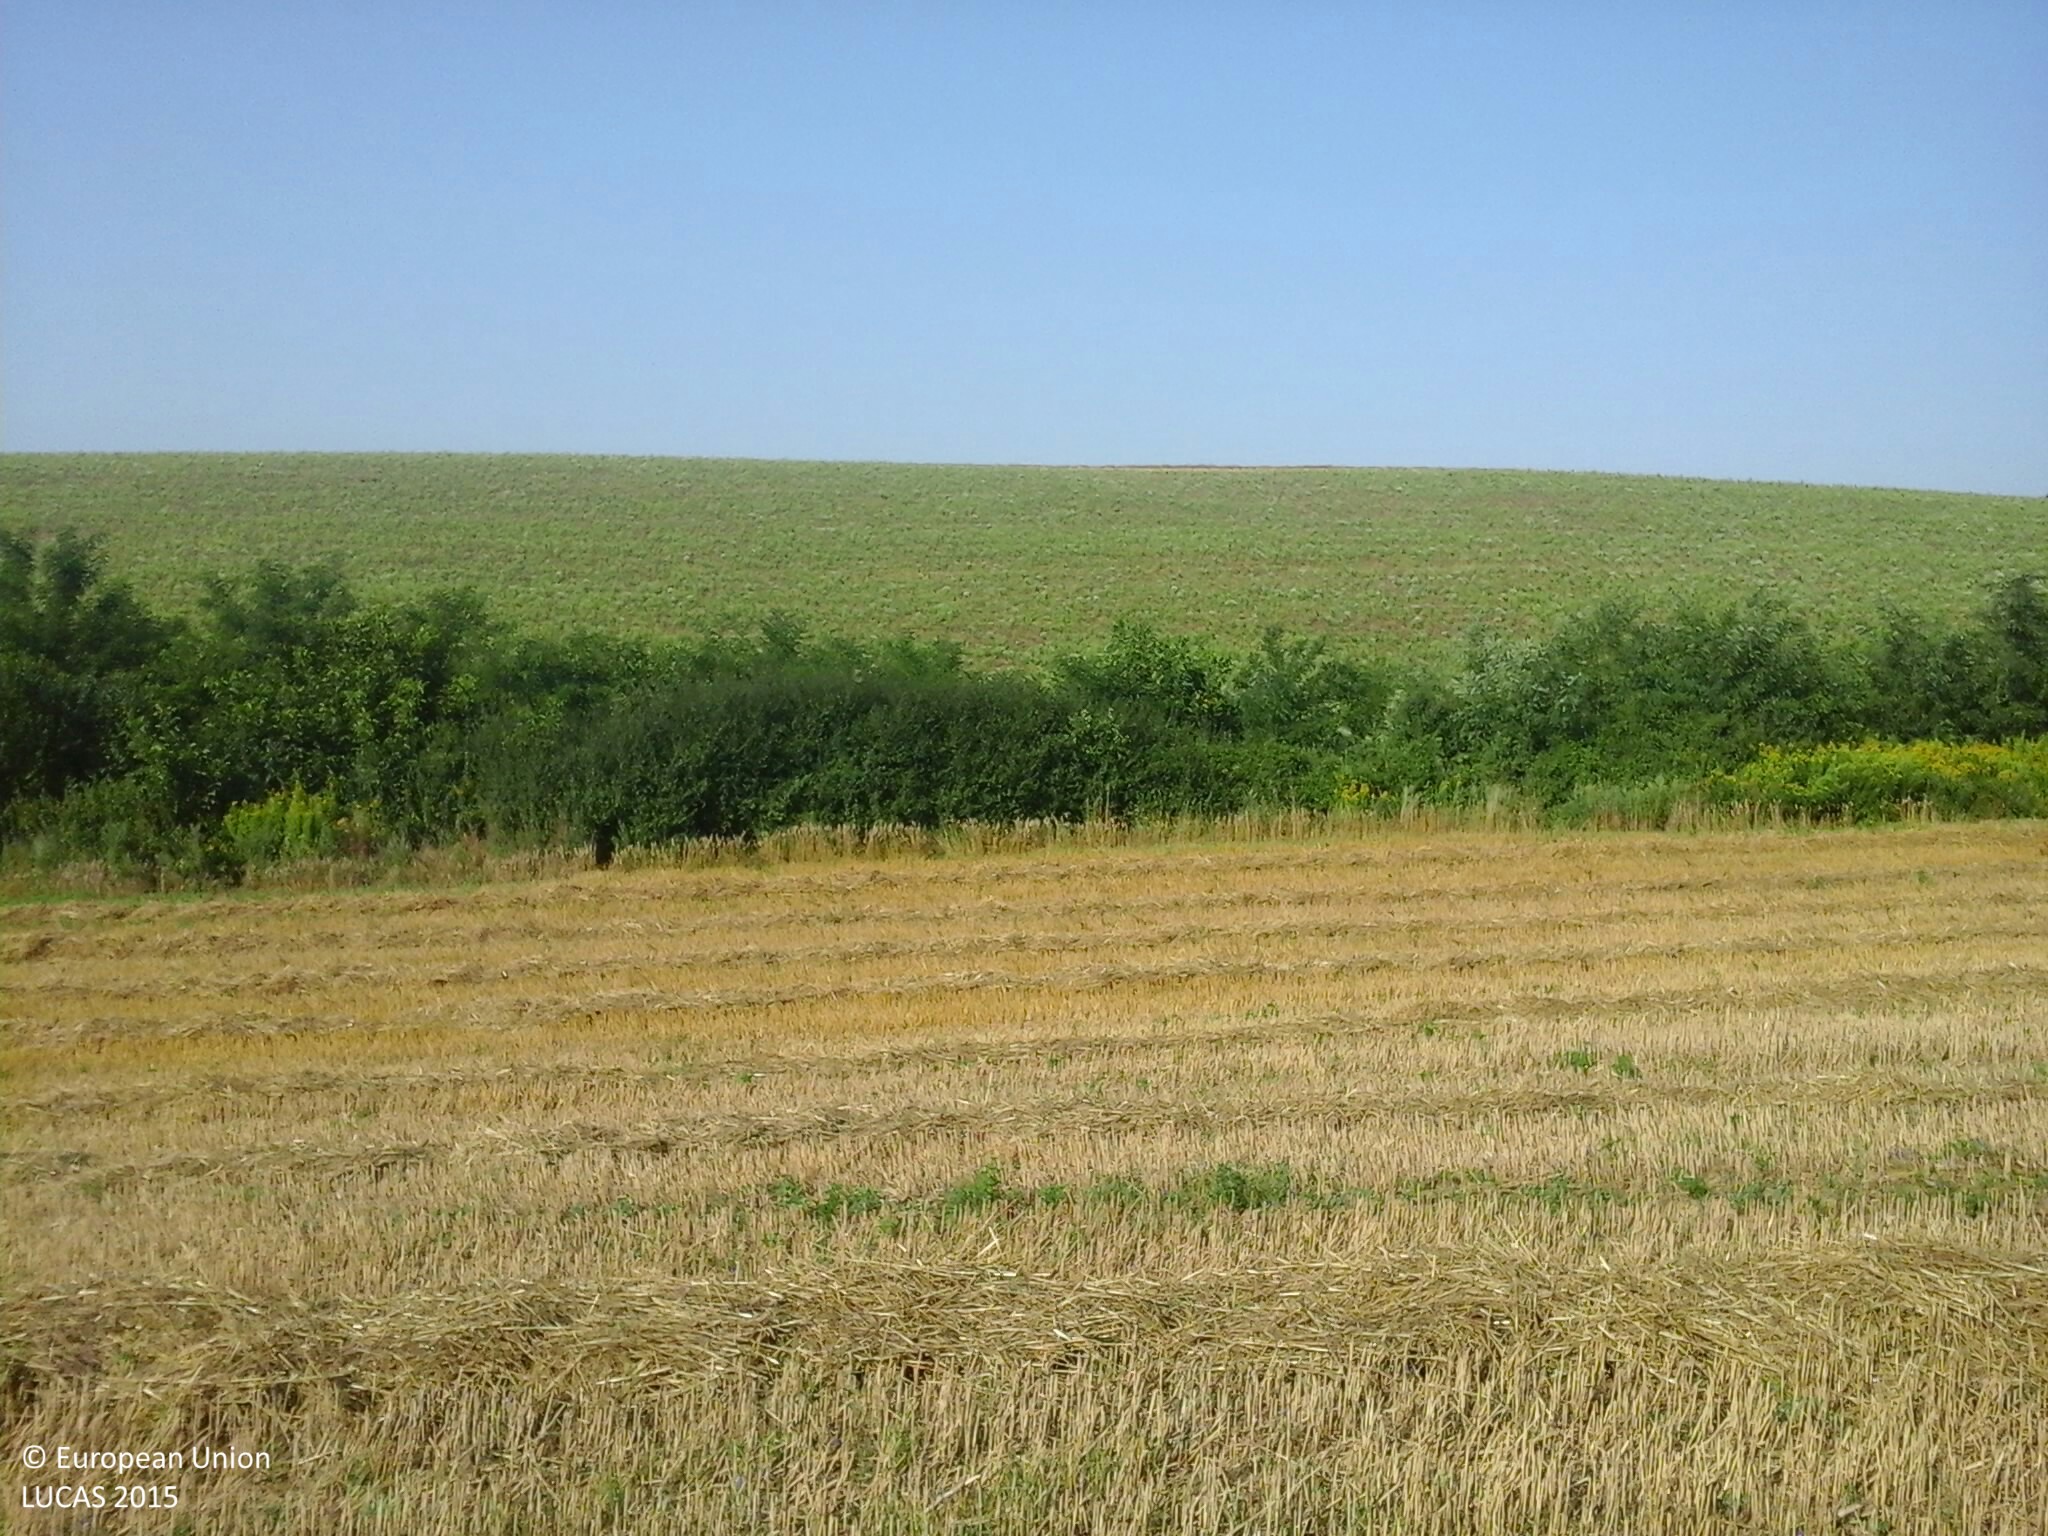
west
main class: Cropland
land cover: Durum wheat
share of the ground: > 75 %
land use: Agriculture (excluding fallow land and kitchen gardens)
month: August
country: HU
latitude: 46.7684
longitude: 18.0883
